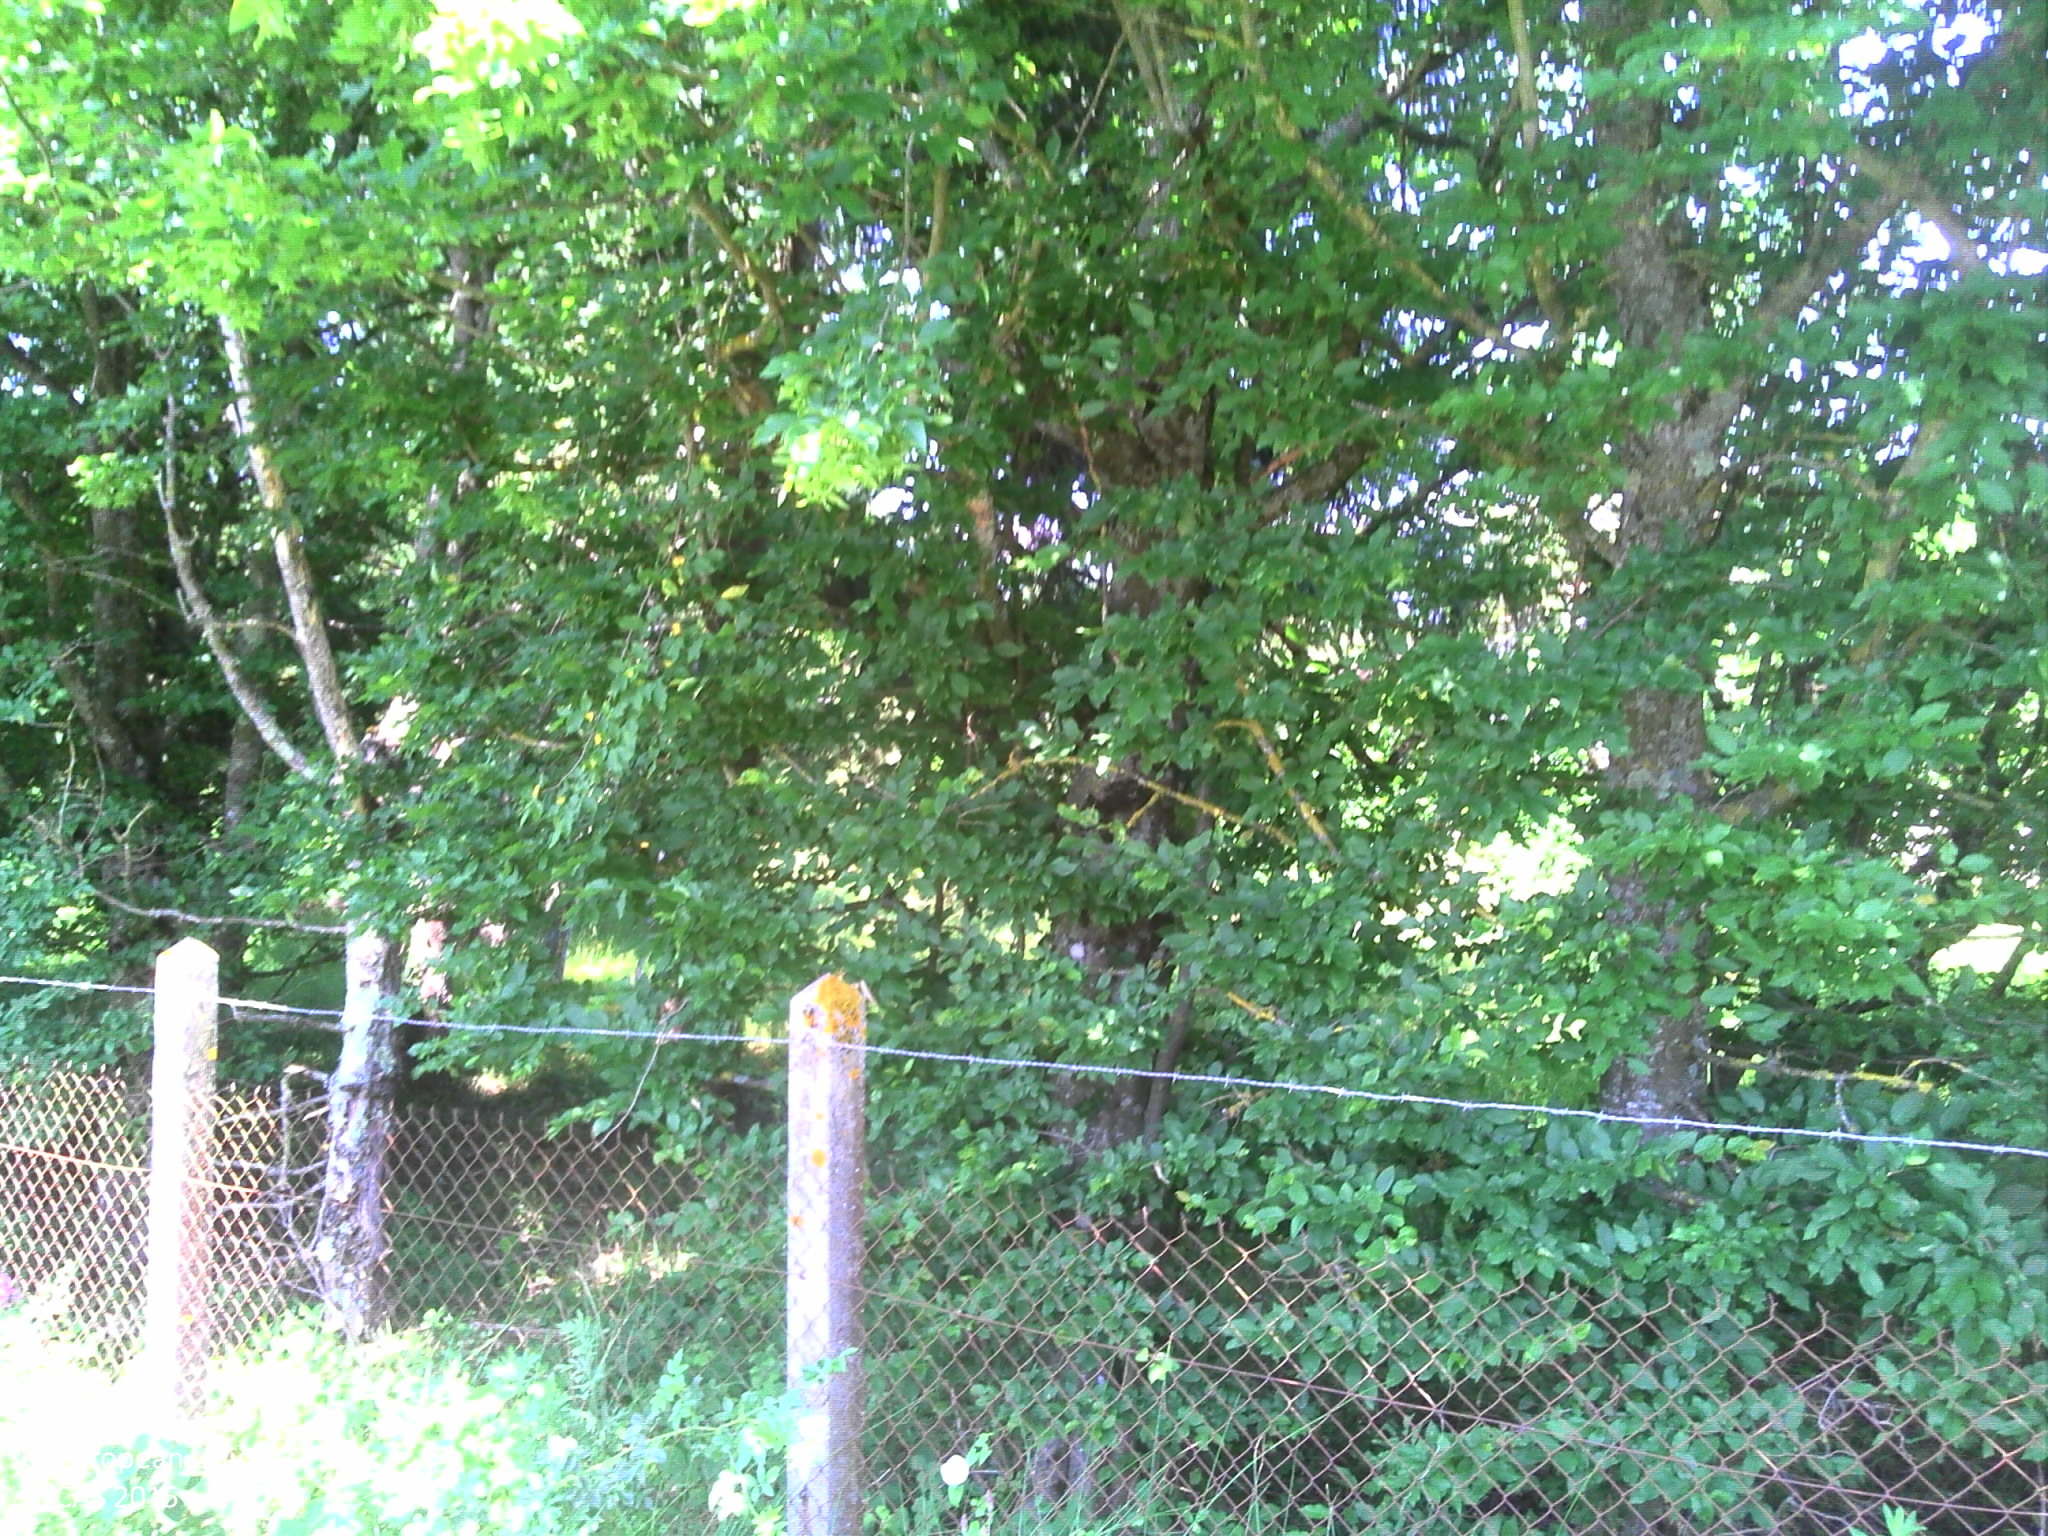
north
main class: Grassland
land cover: Grassland with sparse tree/shrub cover
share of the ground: > 75 %
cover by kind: herbaceous plants 95 %, broadleaved forest trees 5 %
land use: Residential
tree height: > 5 m
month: June
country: FR
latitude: 46.7688
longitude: 5.2484
